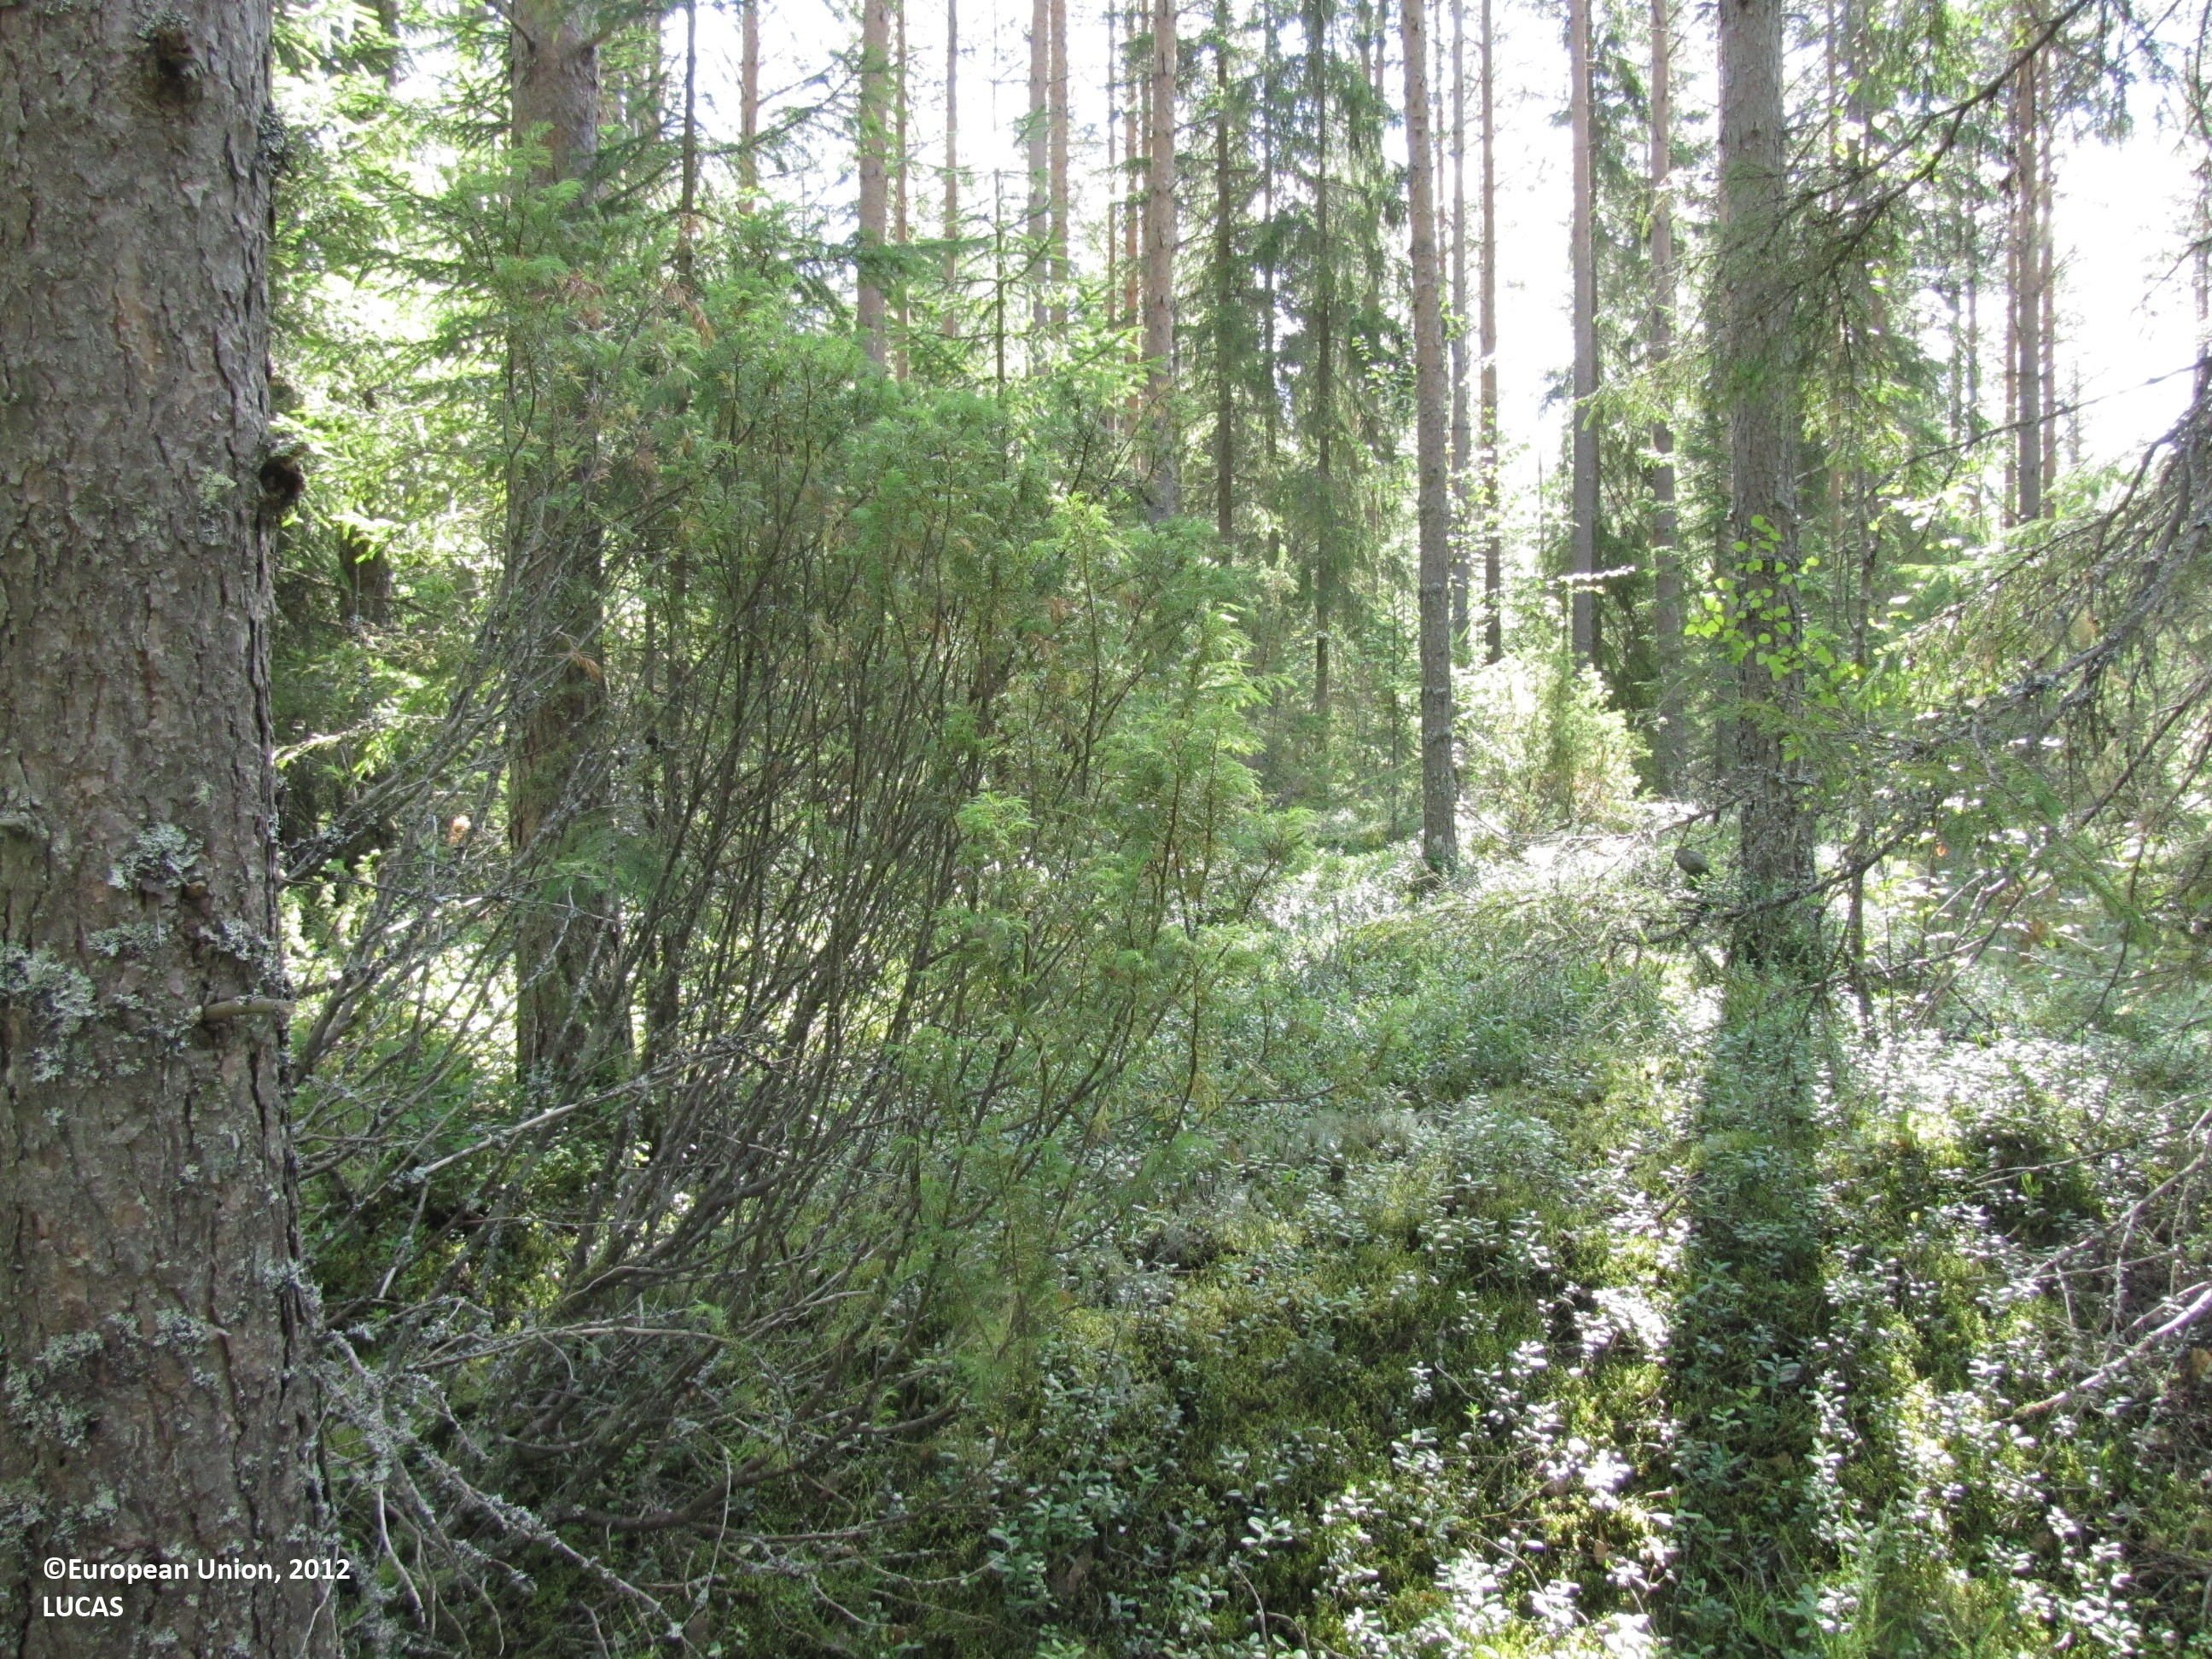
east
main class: Woodland
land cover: Other coniferous woodland
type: boreal forest
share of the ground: > 75 %
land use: Forestry
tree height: > 5 m
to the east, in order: Other coniferous woodland; Pine dominated coniferous woodland; Spruce dominated coniferous woodland; Pine dominated coniferous woodland; Pine dominated mixed woodland; Ditches and canals; Spruce dominated coniferous woodland; Ditches and canals; Grass margins; Tracks; Grass margins; Ditches and canals; Spruce dominated coniferous woodland
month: July
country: FI
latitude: 62.1163
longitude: 23.2376
